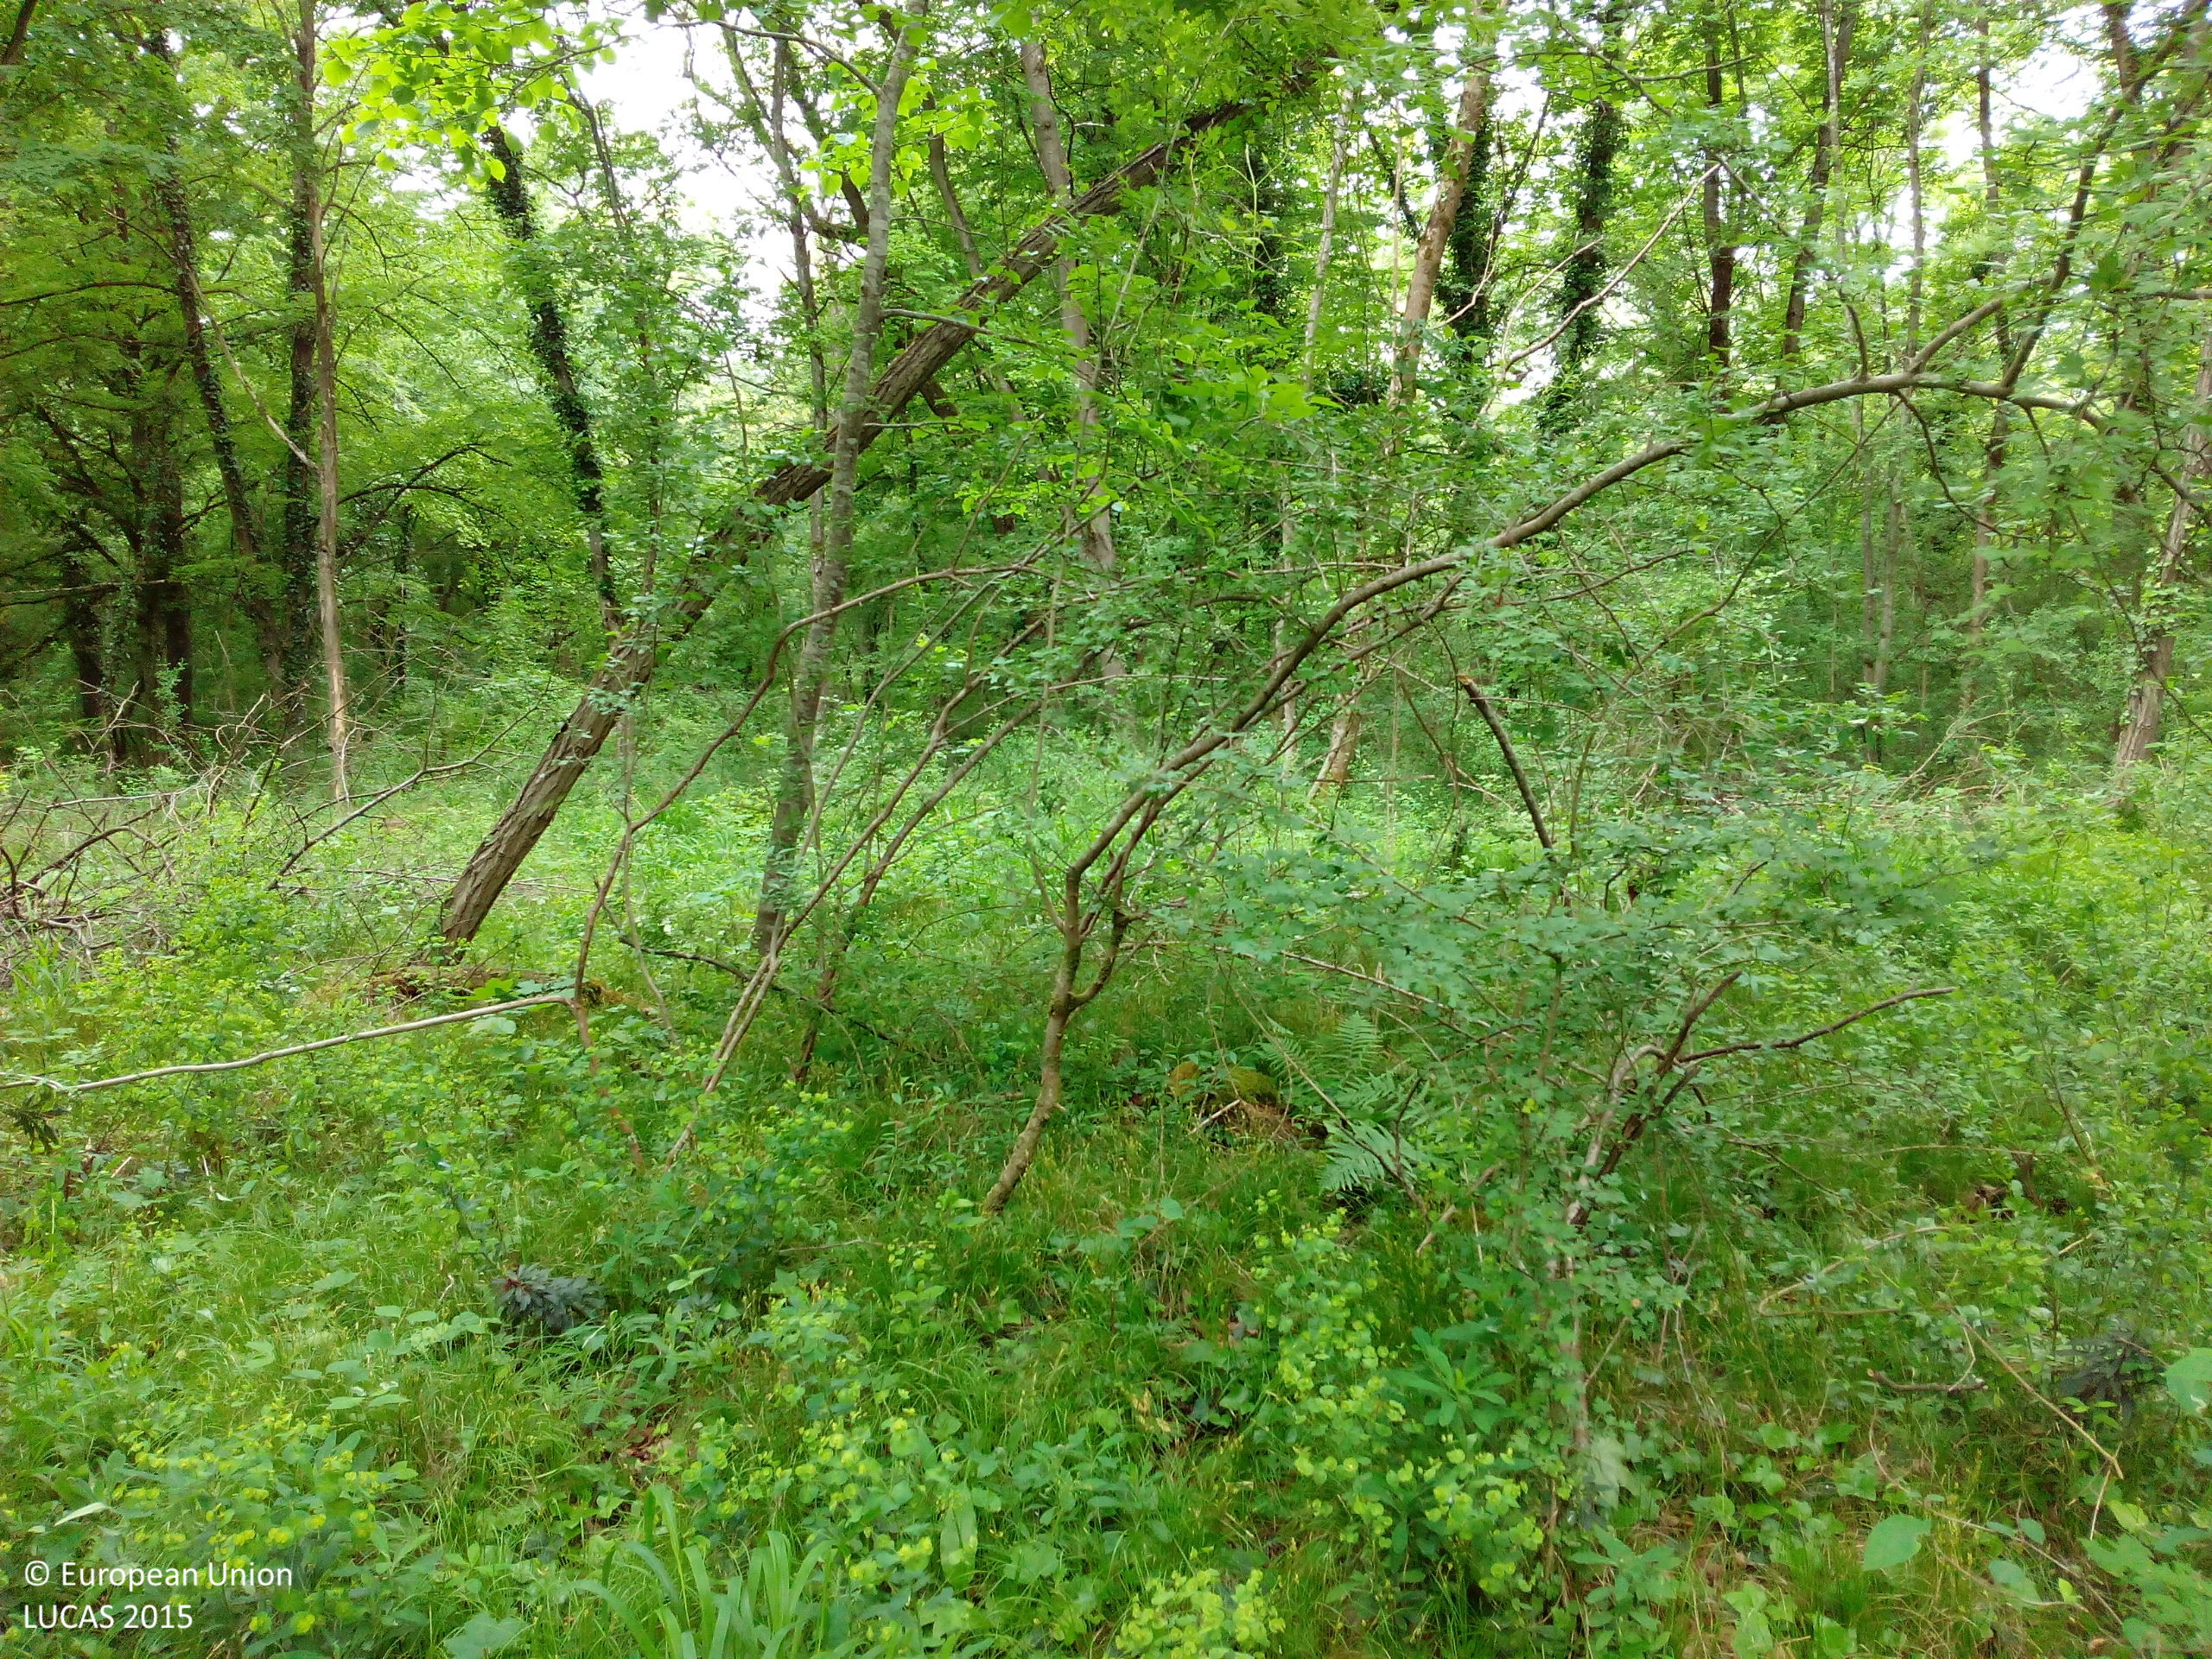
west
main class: Woodland
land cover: Broadleaved woodland
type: floodplain forest
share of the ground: > 75 %
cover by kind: broadleaved forest trees 85 %, shrubs 10 %, herbaceous plants 5 %
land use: Forestry
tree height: > 5 m
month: May
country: DE
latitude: 47.9641
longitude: 7.6306
